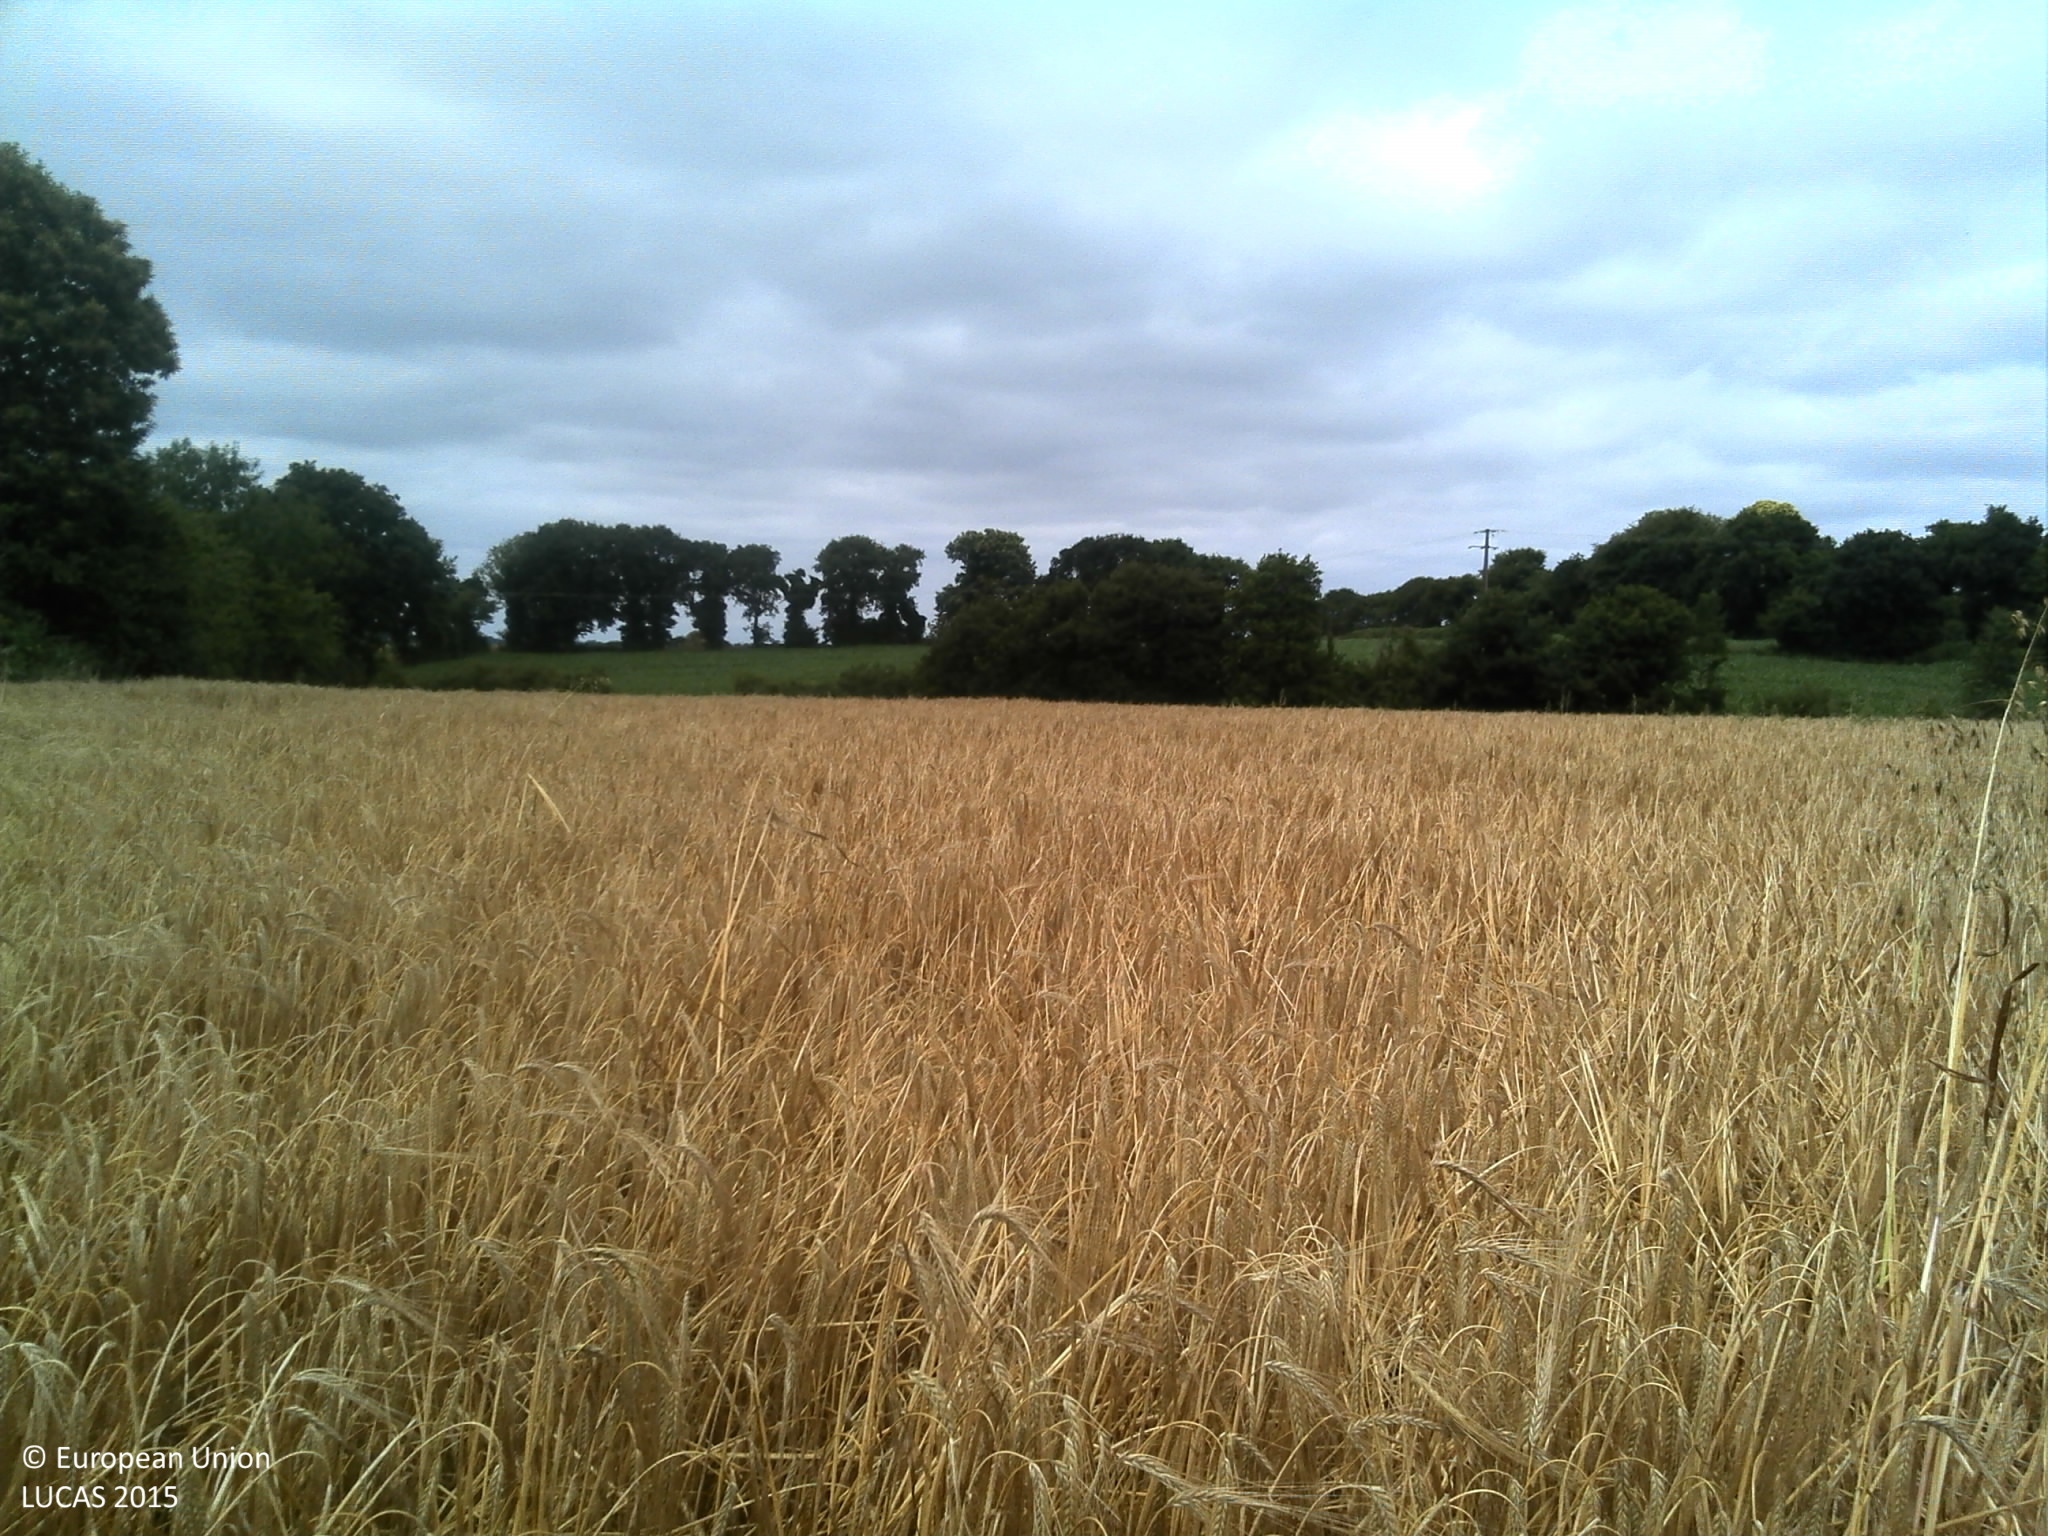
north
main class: Cropland
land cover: Barley
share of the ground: > 75 %
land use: Agriculture (excluding fallow land and kitchen gardens)
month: July
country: FR
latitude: 48.5959
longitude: -3.7658
